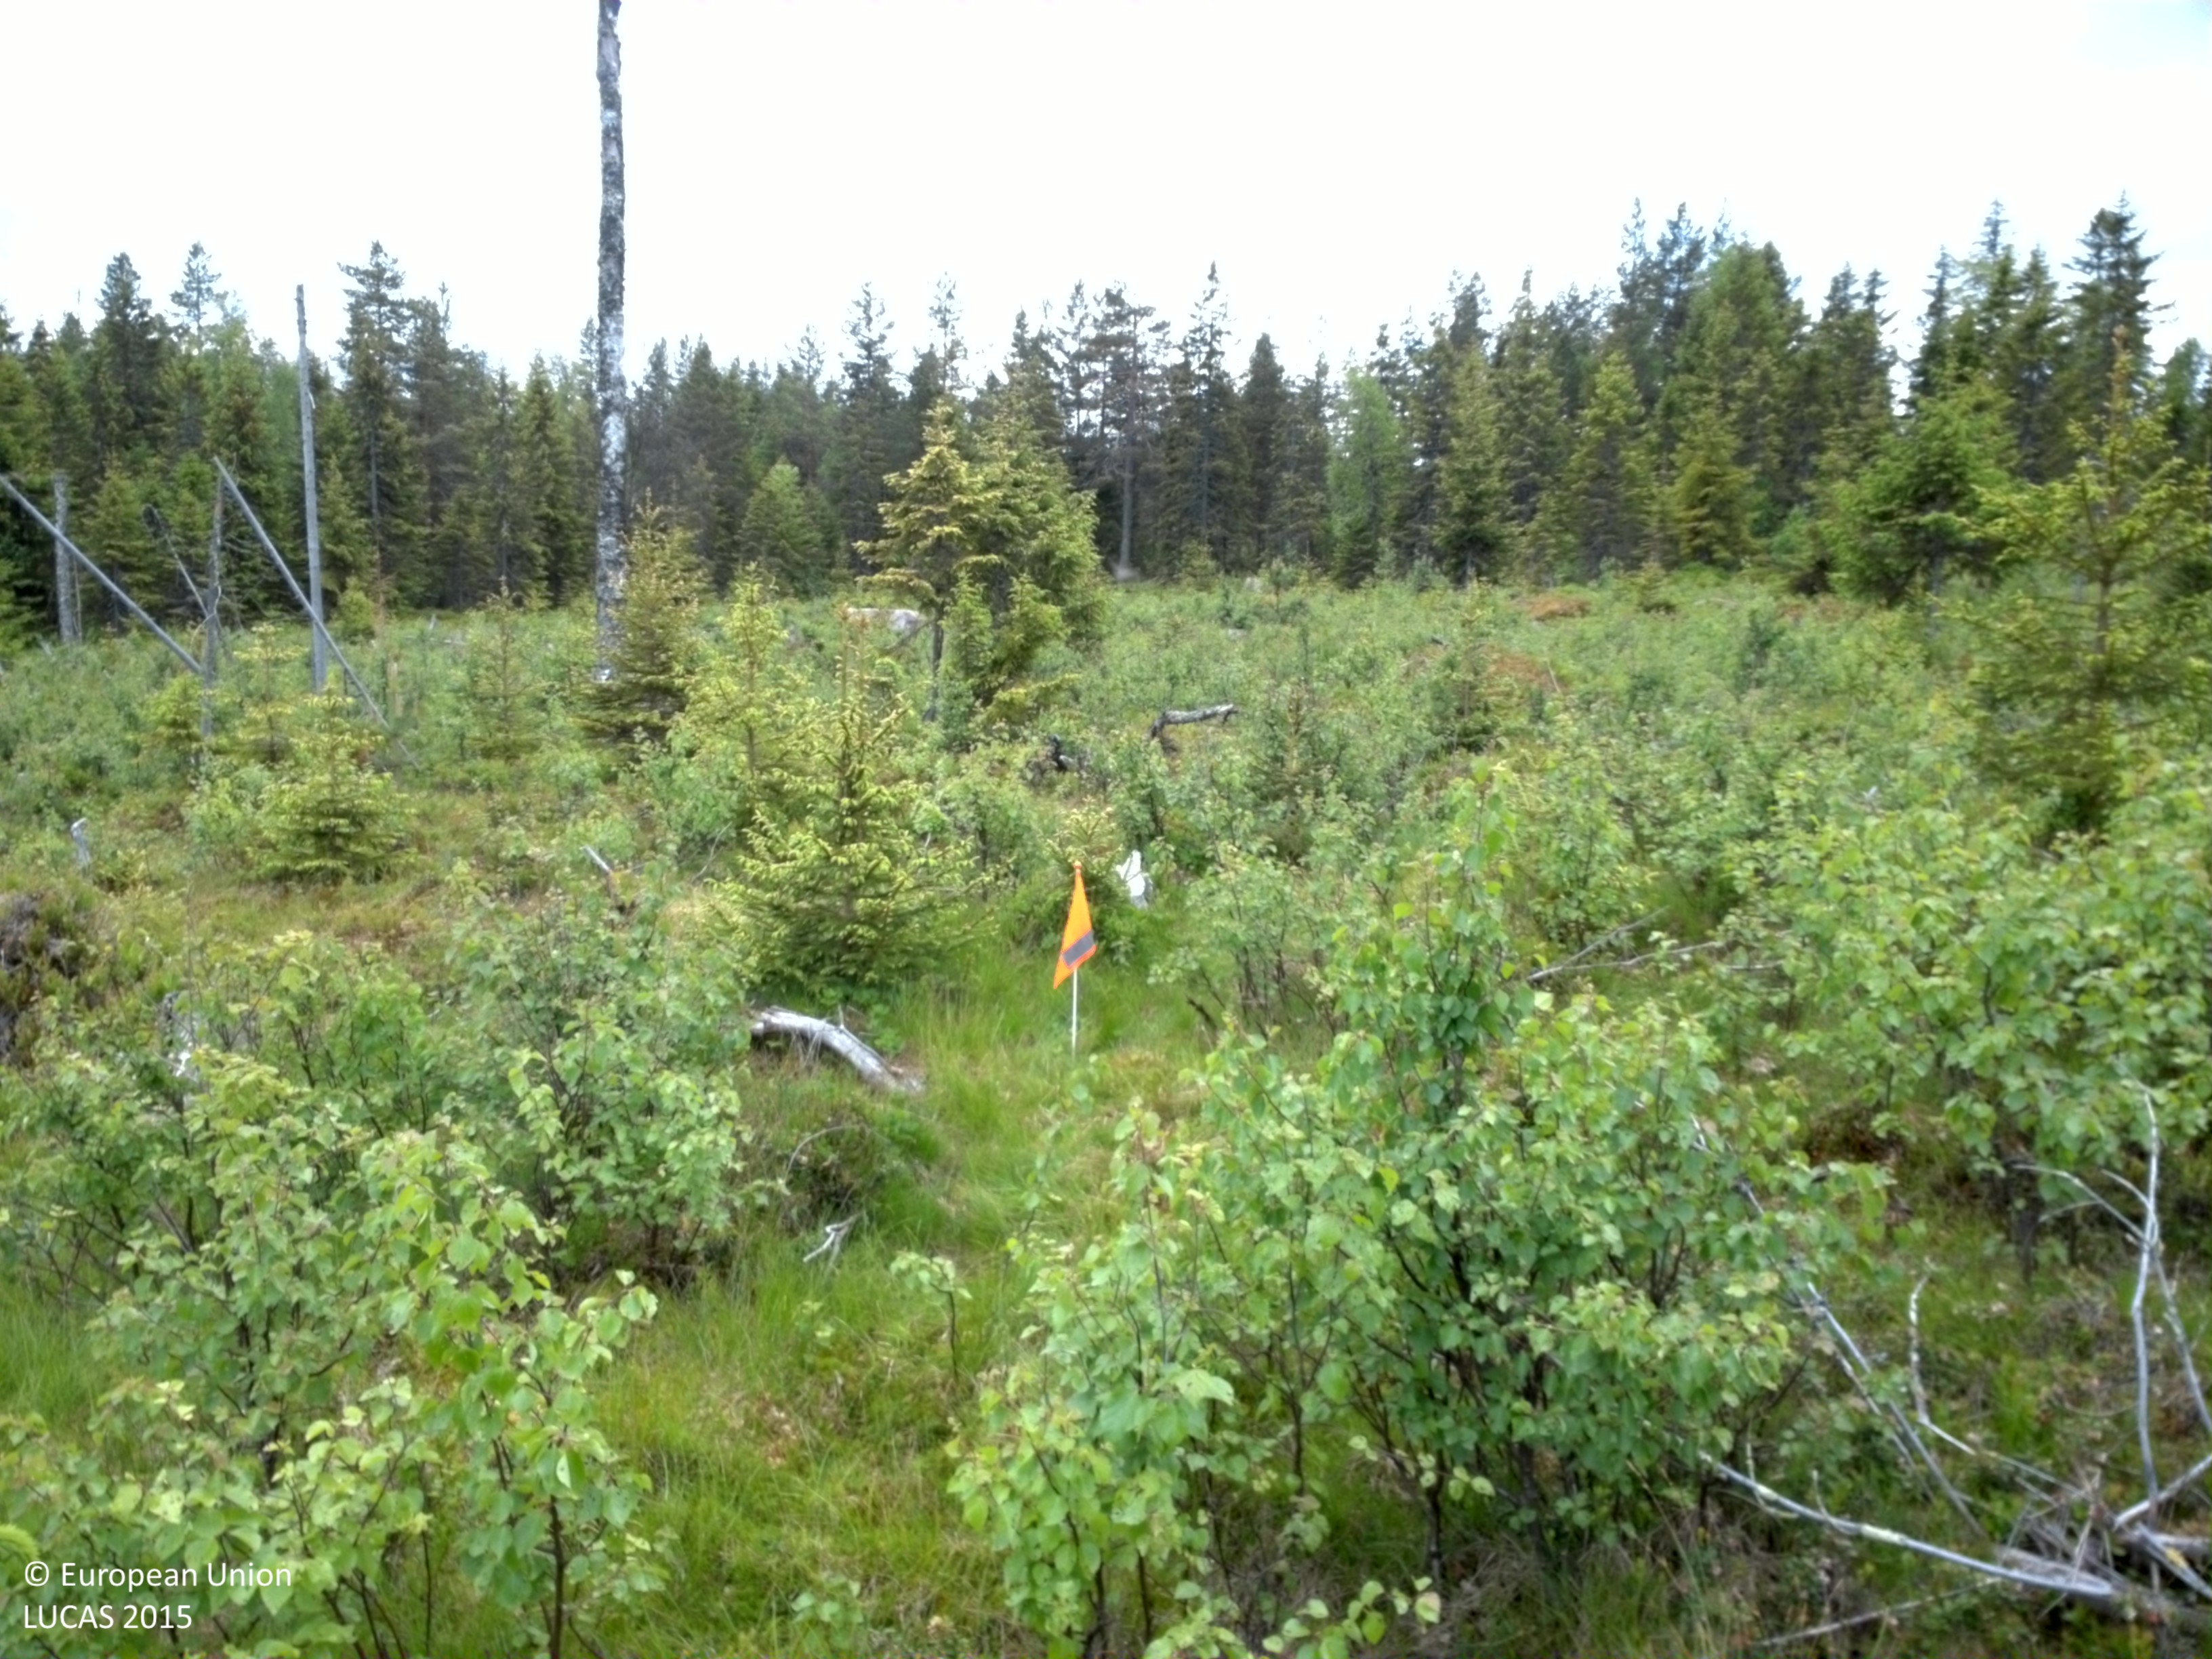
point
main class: Woodland
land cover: Spruce dominated mixed woodland
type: boreal forest
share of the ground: 10 - 25 %
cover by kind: herbaceous plants 65 %, shrubs 15 %, broadleaved forest trees 10 %, coniferous forest trees 5 %, lichens and mosses 5 %
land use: Forestry
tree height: < 5 m
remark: Clear cut
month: June
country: SE
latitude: 60.6628
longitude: 12.4985
